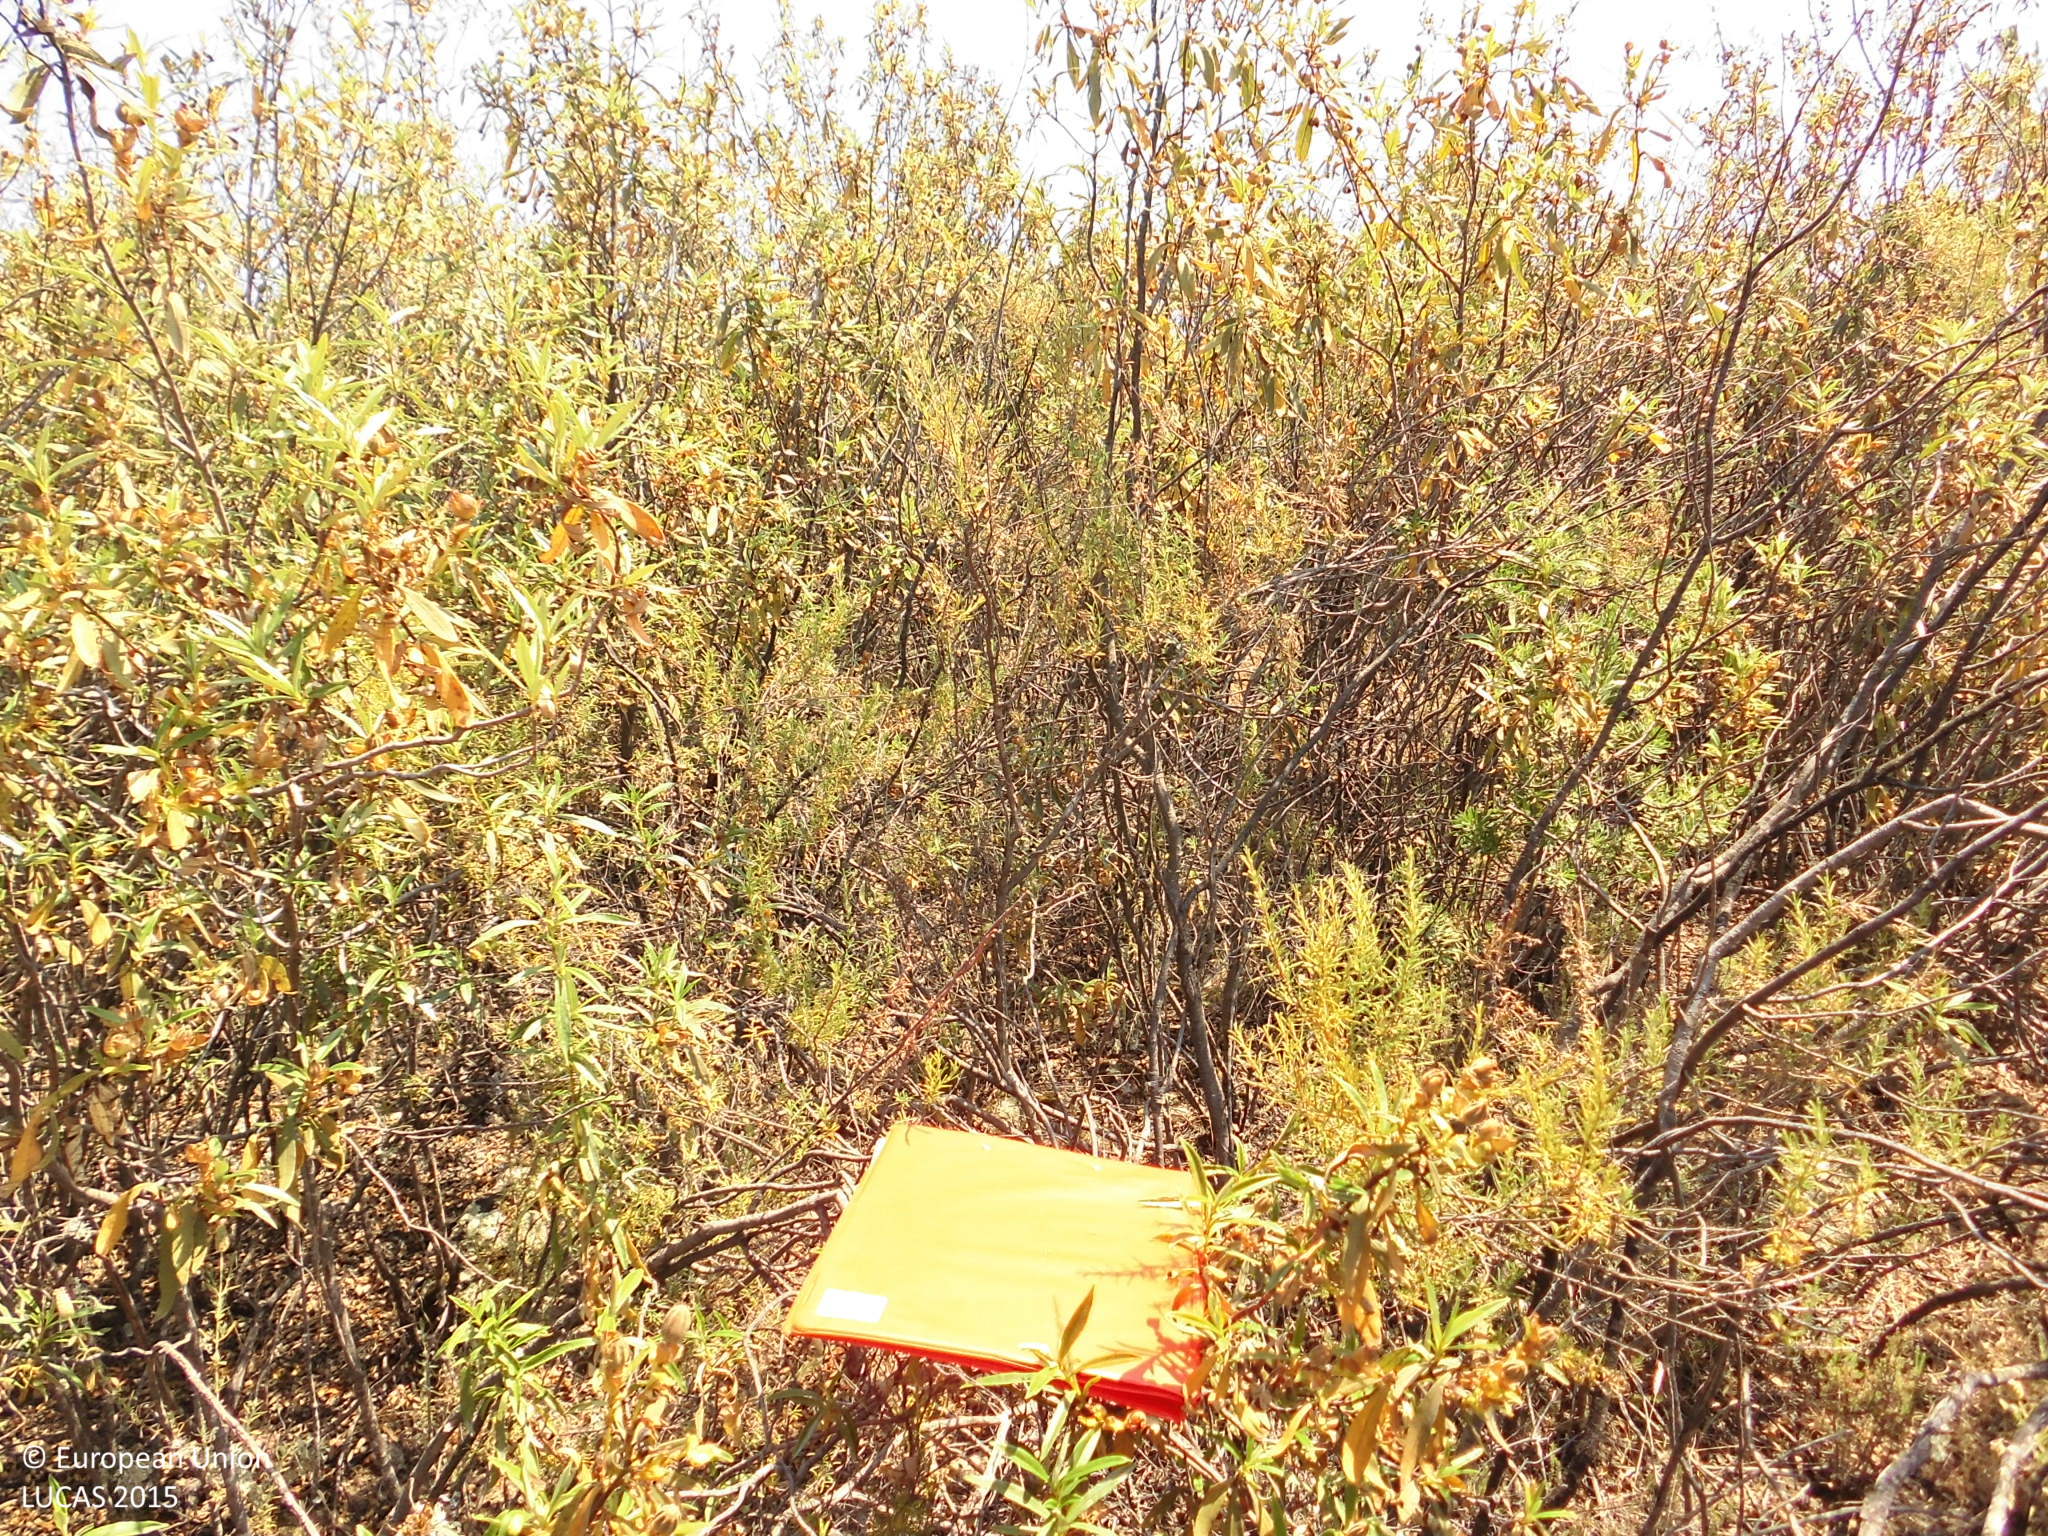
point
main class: Shrubland
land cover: Shrubland without tree cover
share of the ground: > 75 %
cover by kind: shrubs 90 %, herbaceous plants 10 %
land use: Abandoned areas
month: June
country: ES
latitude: 40.0956
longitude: -5.4855
